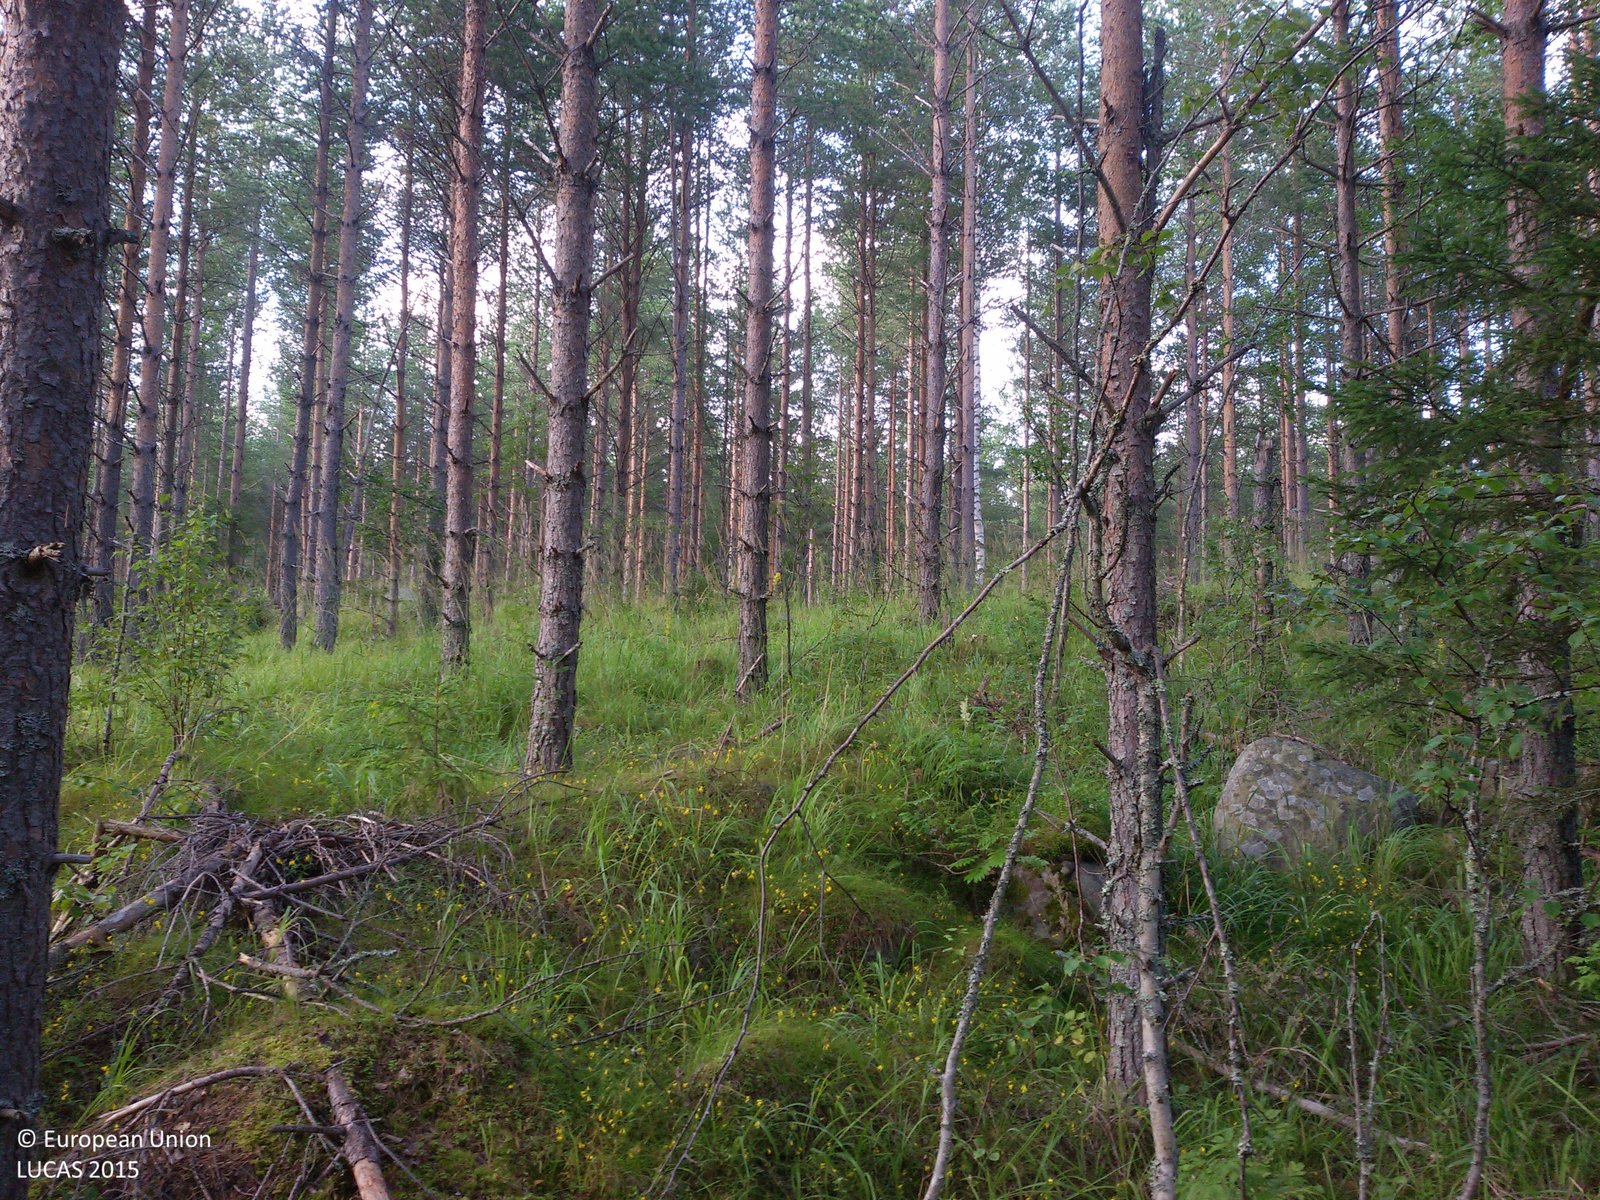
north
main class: Woodland
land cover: Pine dominated coniferous woodland
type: boreal forest
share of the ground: 50 - 75 %
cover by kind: coniferous forest trees 60 %, herbaceous plants 25 %, lichens and mosses 10 %, broadleaved forest trees 5 %
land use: Forestry
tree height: > 5 m
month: August
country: SE
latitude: 60.8433
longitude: 16.5192
